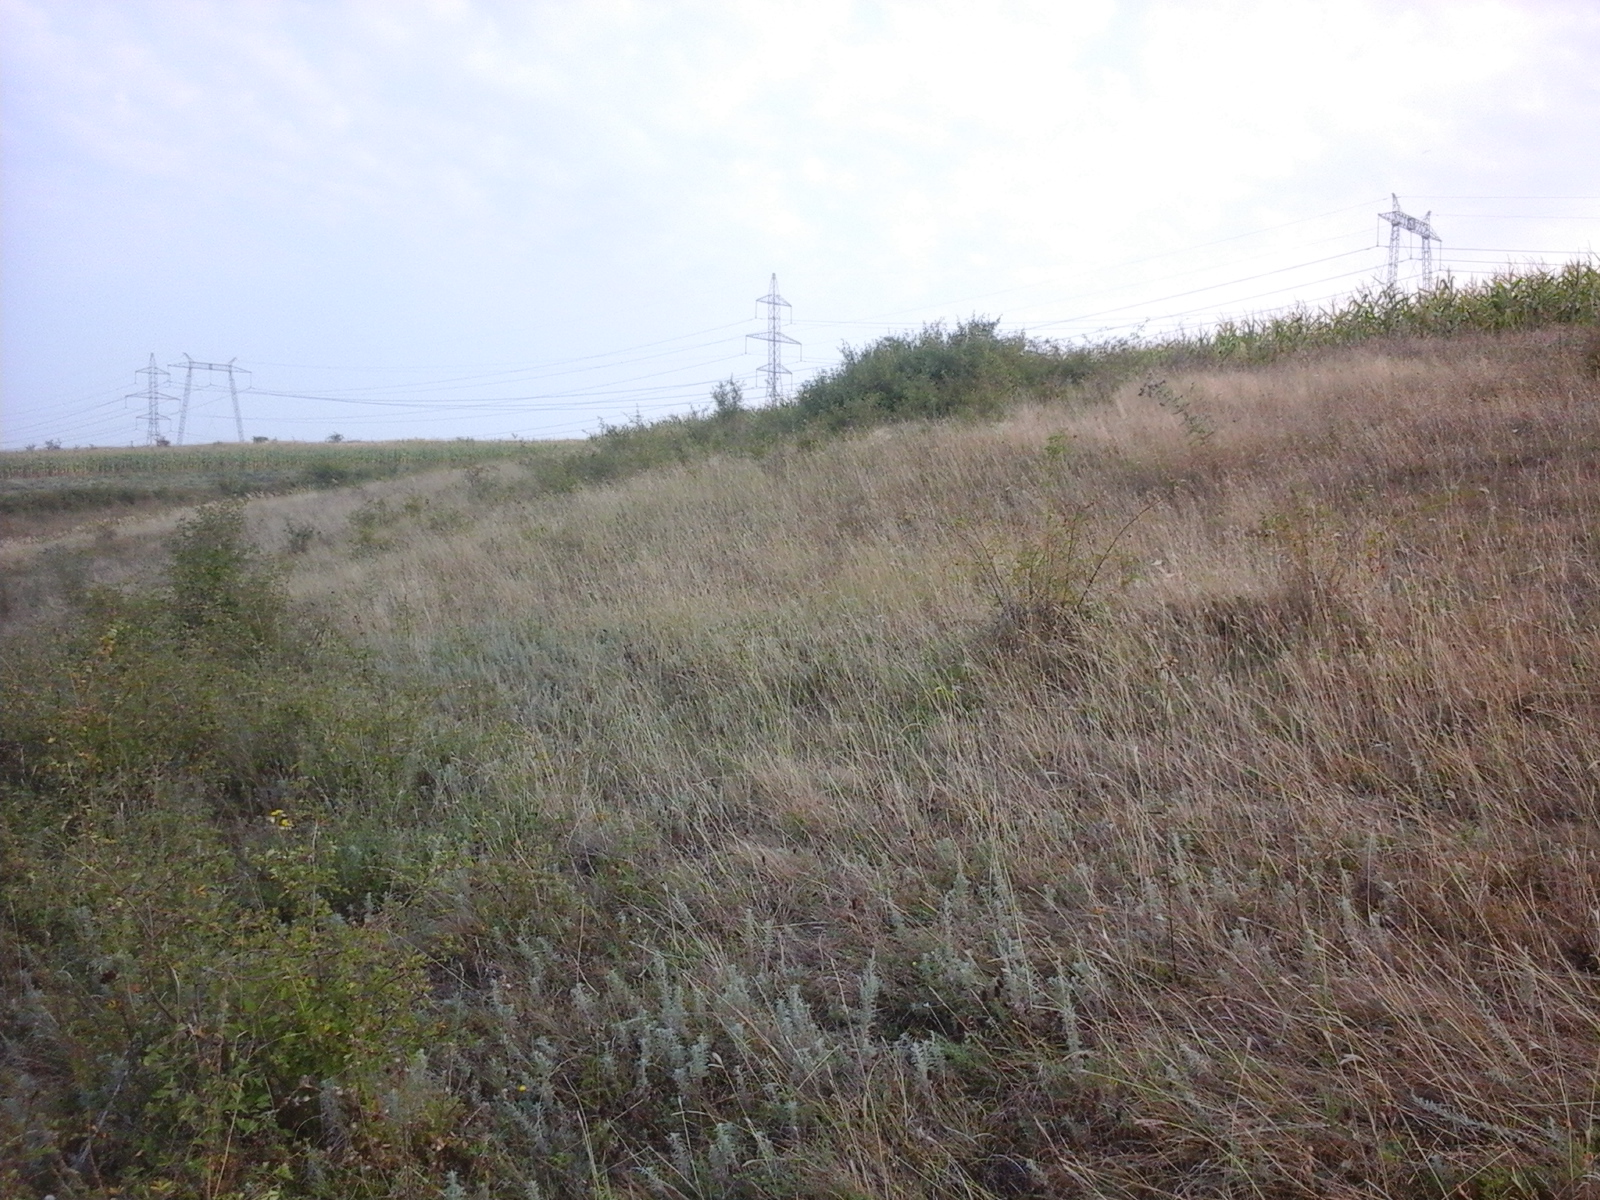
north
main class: Grassland
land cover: Grassland with sparse tree/shrub cover
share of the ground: > 75 %
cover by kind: herbaceous plants 90 %, broadleaved forest trees 5 %, shrubs 5 %
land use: Fallow land
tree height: < 5 m
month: August
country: RO
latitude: 44.4976
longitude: 23.8301
